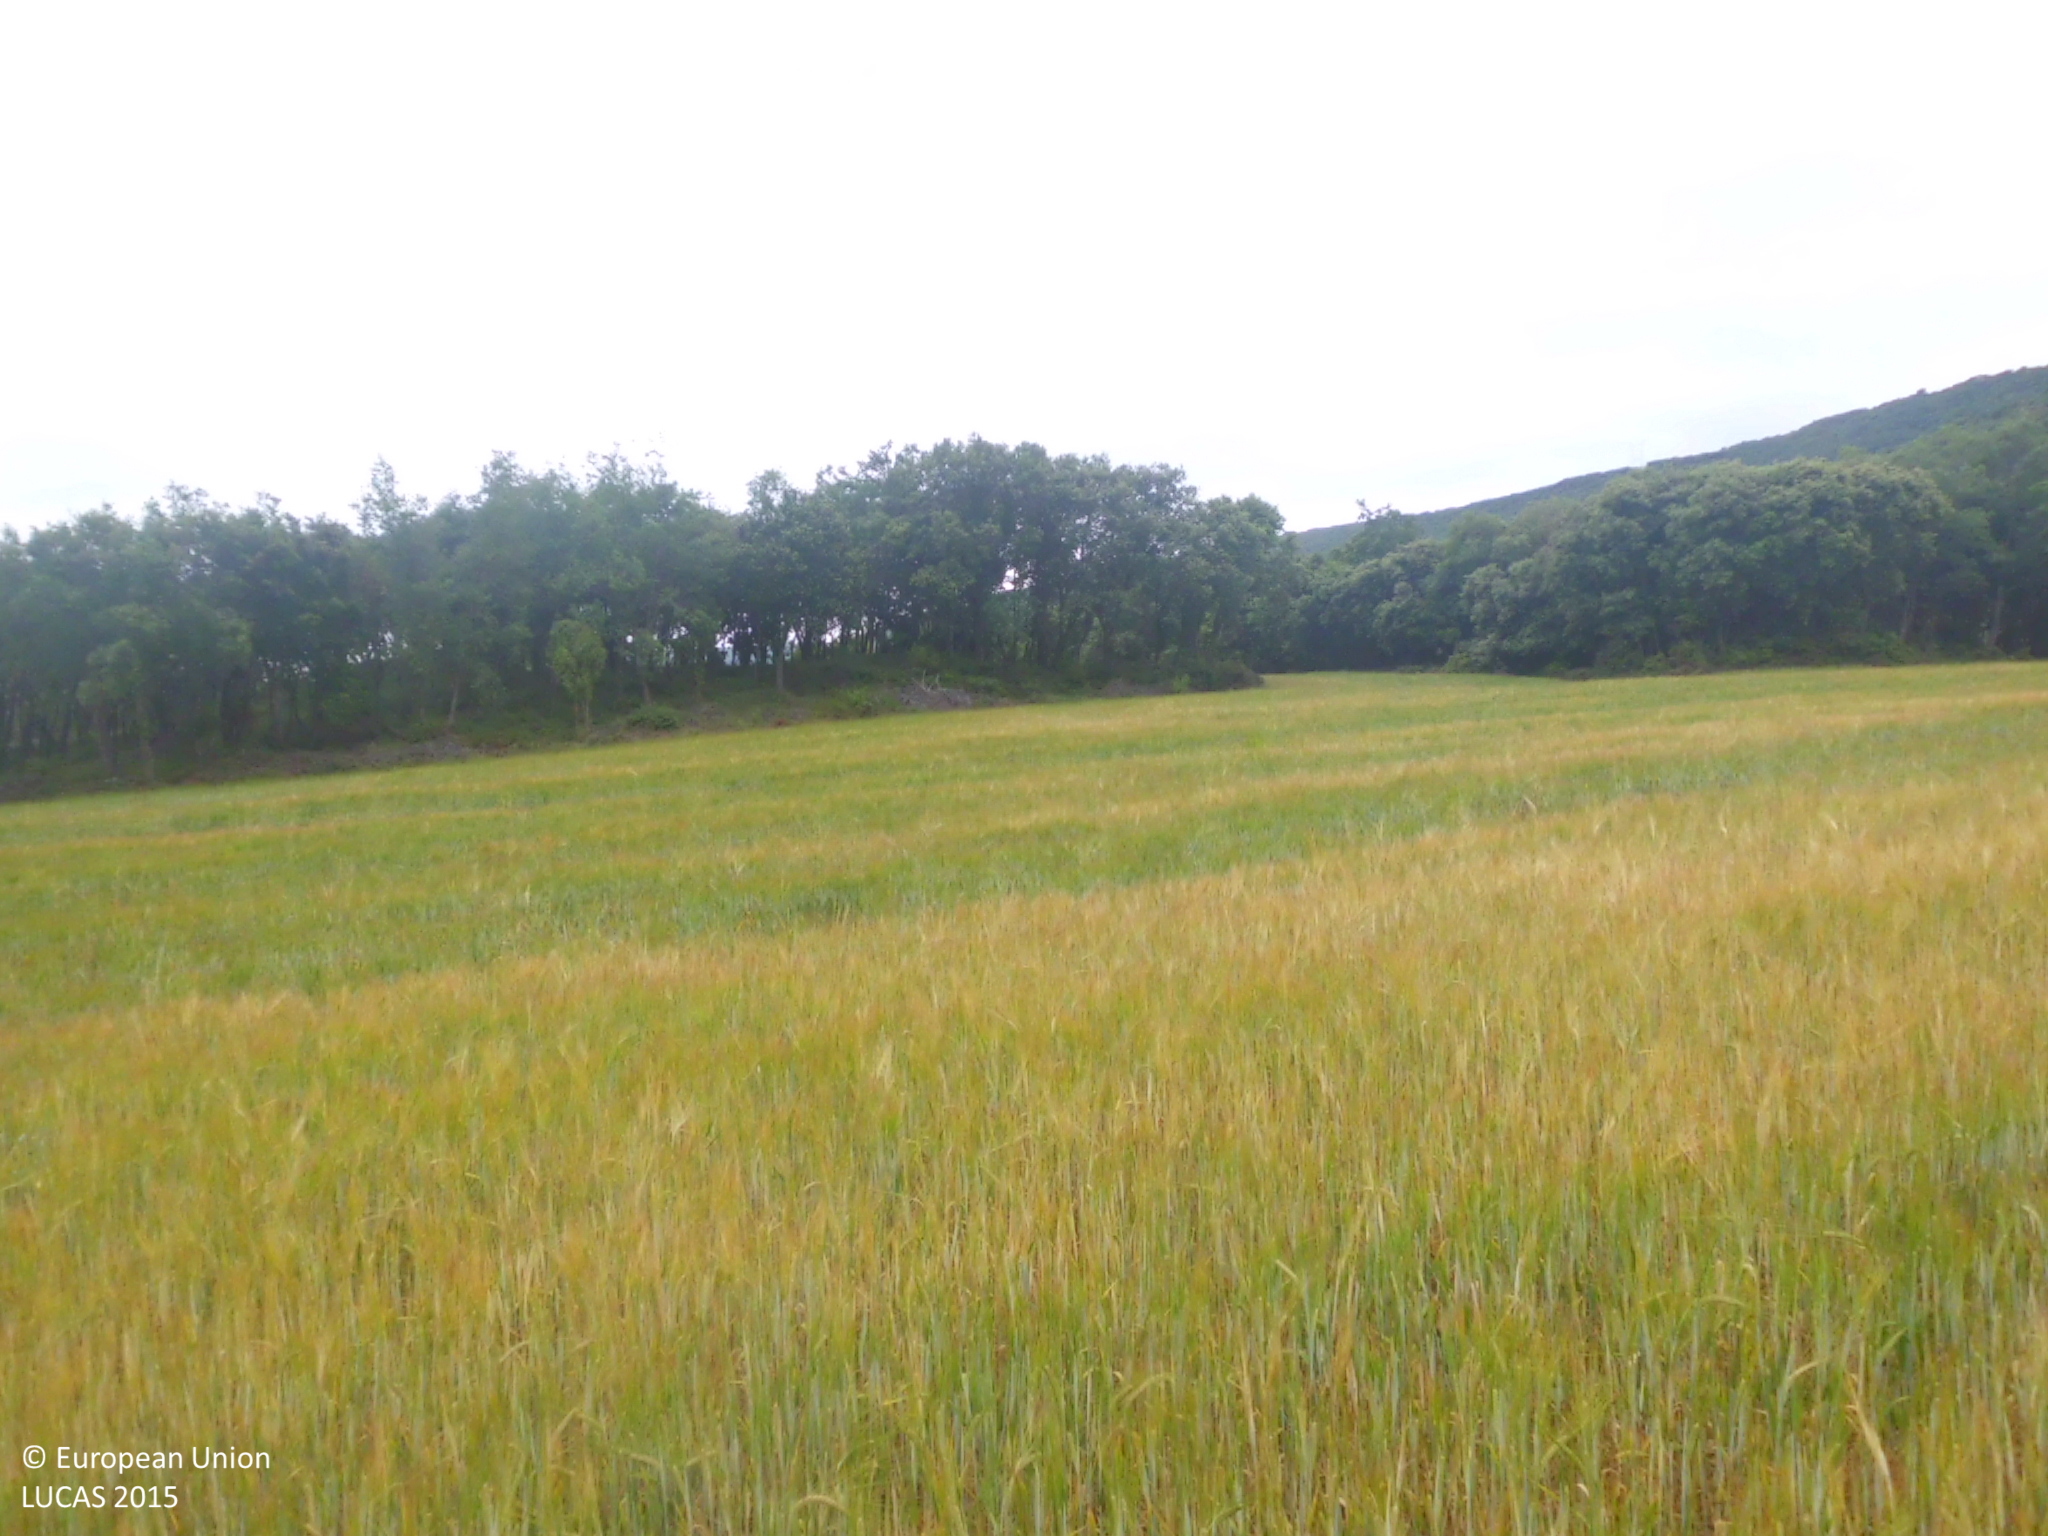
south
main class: Cropland
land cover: Barley
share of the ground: > 75 %
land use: Agriculture (excluding fallow land and kitchen gardens)
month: June
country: ES
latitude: 42.6938
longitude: -3.1041
